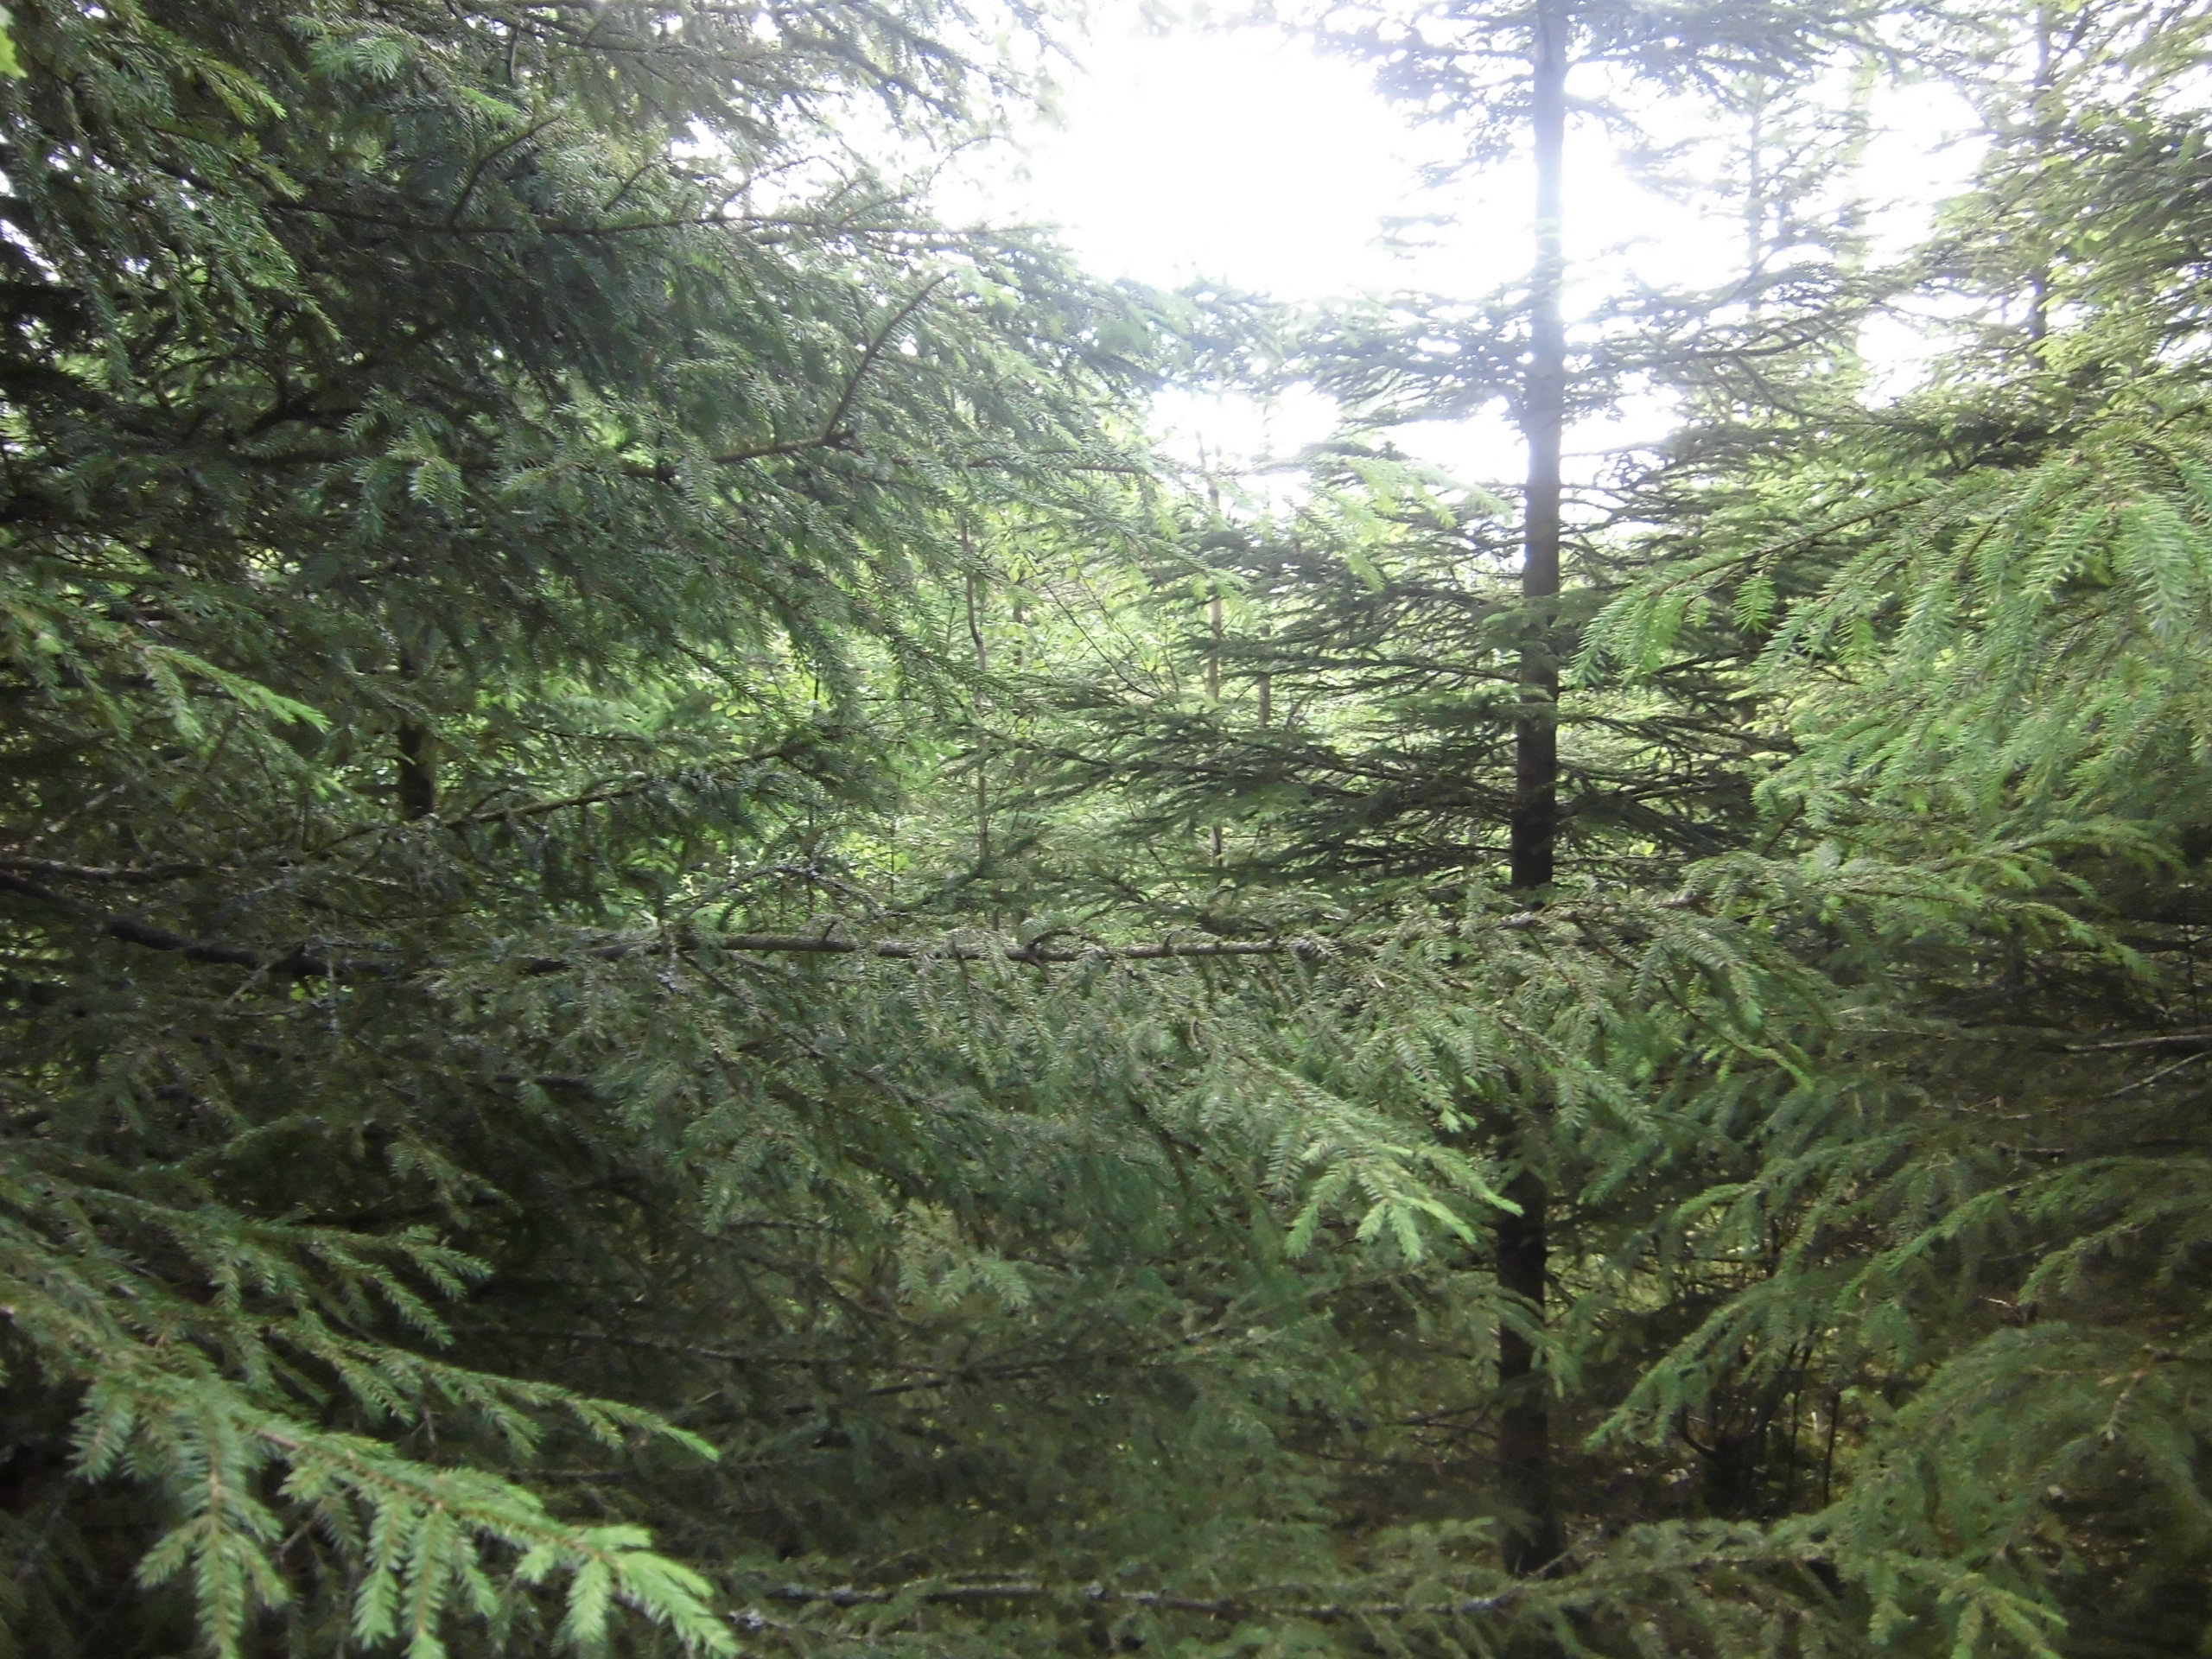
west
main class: Woodland
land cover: Spruce dominated coniferous woodland
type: boreal forest
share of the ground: > 75 %
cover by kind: coniferous forest trees 75 %, lichens and mosses 15 %, broadleaved forest trees 5 %, herbaceous plants 5 %
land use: Forestry
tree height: > 5 m
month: July
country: SE
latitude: 57.2465
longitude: 14.9186
